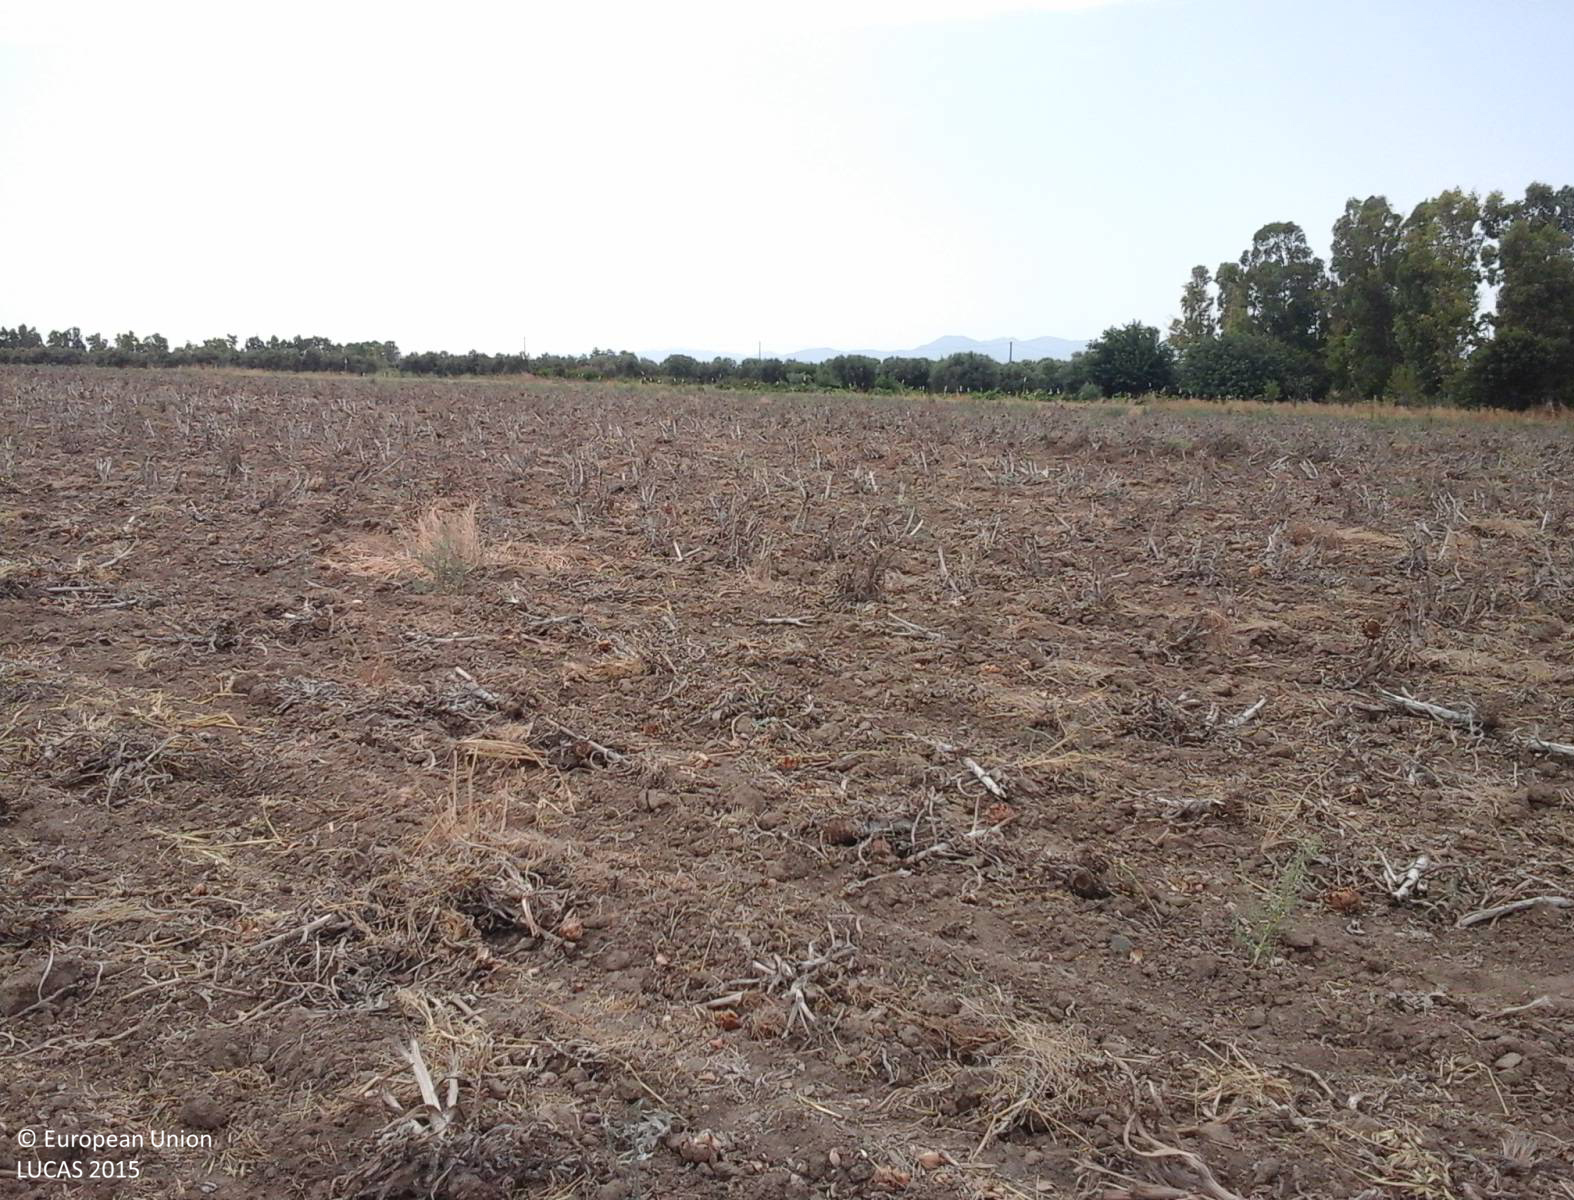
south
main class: Cropland
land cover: Other fresh vegetables
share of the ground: > 75 %
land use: Agriculture (excluding fallow land and kitchen gardens)
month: July
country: IT
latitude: 39.4821
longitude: 8.8790
